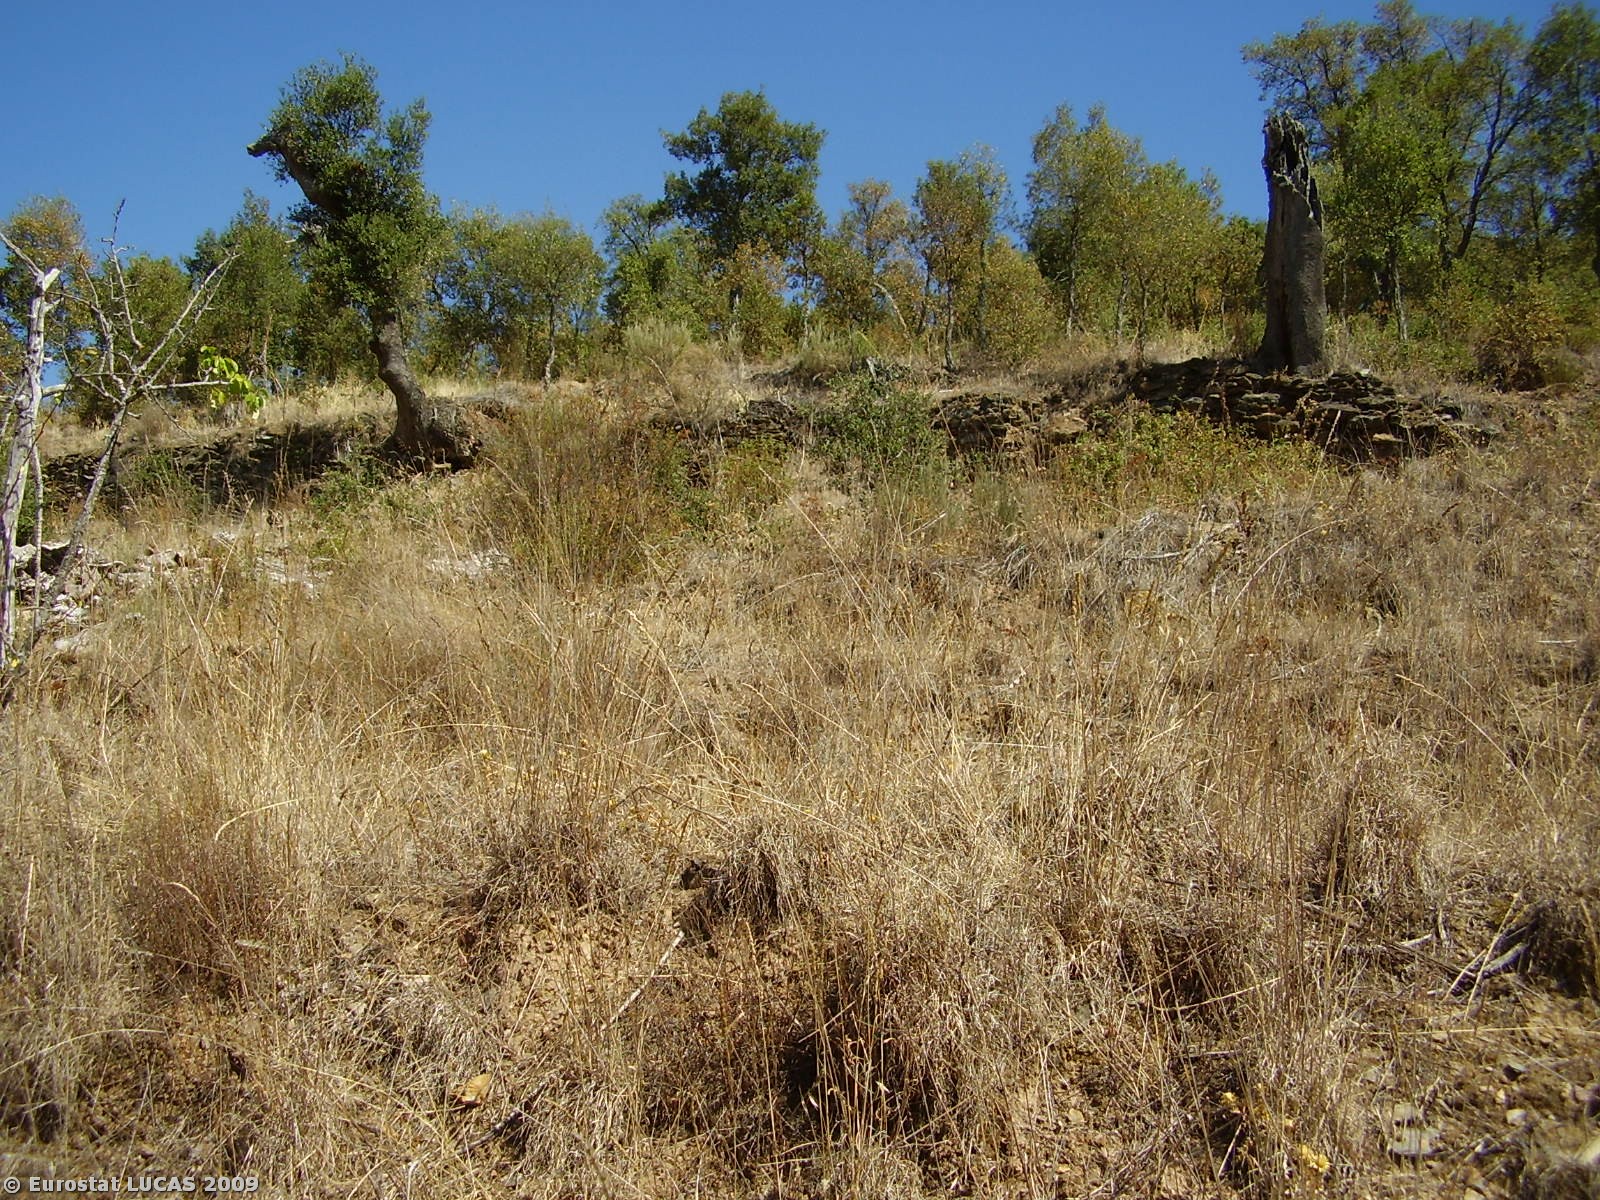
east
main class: Cropland
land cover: Olive groves
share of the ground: 10 - 25 %
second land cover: Spontaneously vegetated surfaces
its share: 10 - 25 %
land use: Agriculture (excluding fallow land and kitchen gardens)
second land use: Fallow land
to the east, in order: Olive groves; Spontaneously vegetated surfaces; Olive groves; Broadleaved woodland; Tracks; Broadleaved woodland; Paved roads, cycling and walking lanes; Rivers and streams; Electric lines; Shrubland without tree cover; Oats; Electric lines; Oats
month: August
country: PT
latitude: 41.2432
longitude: -6.7749
